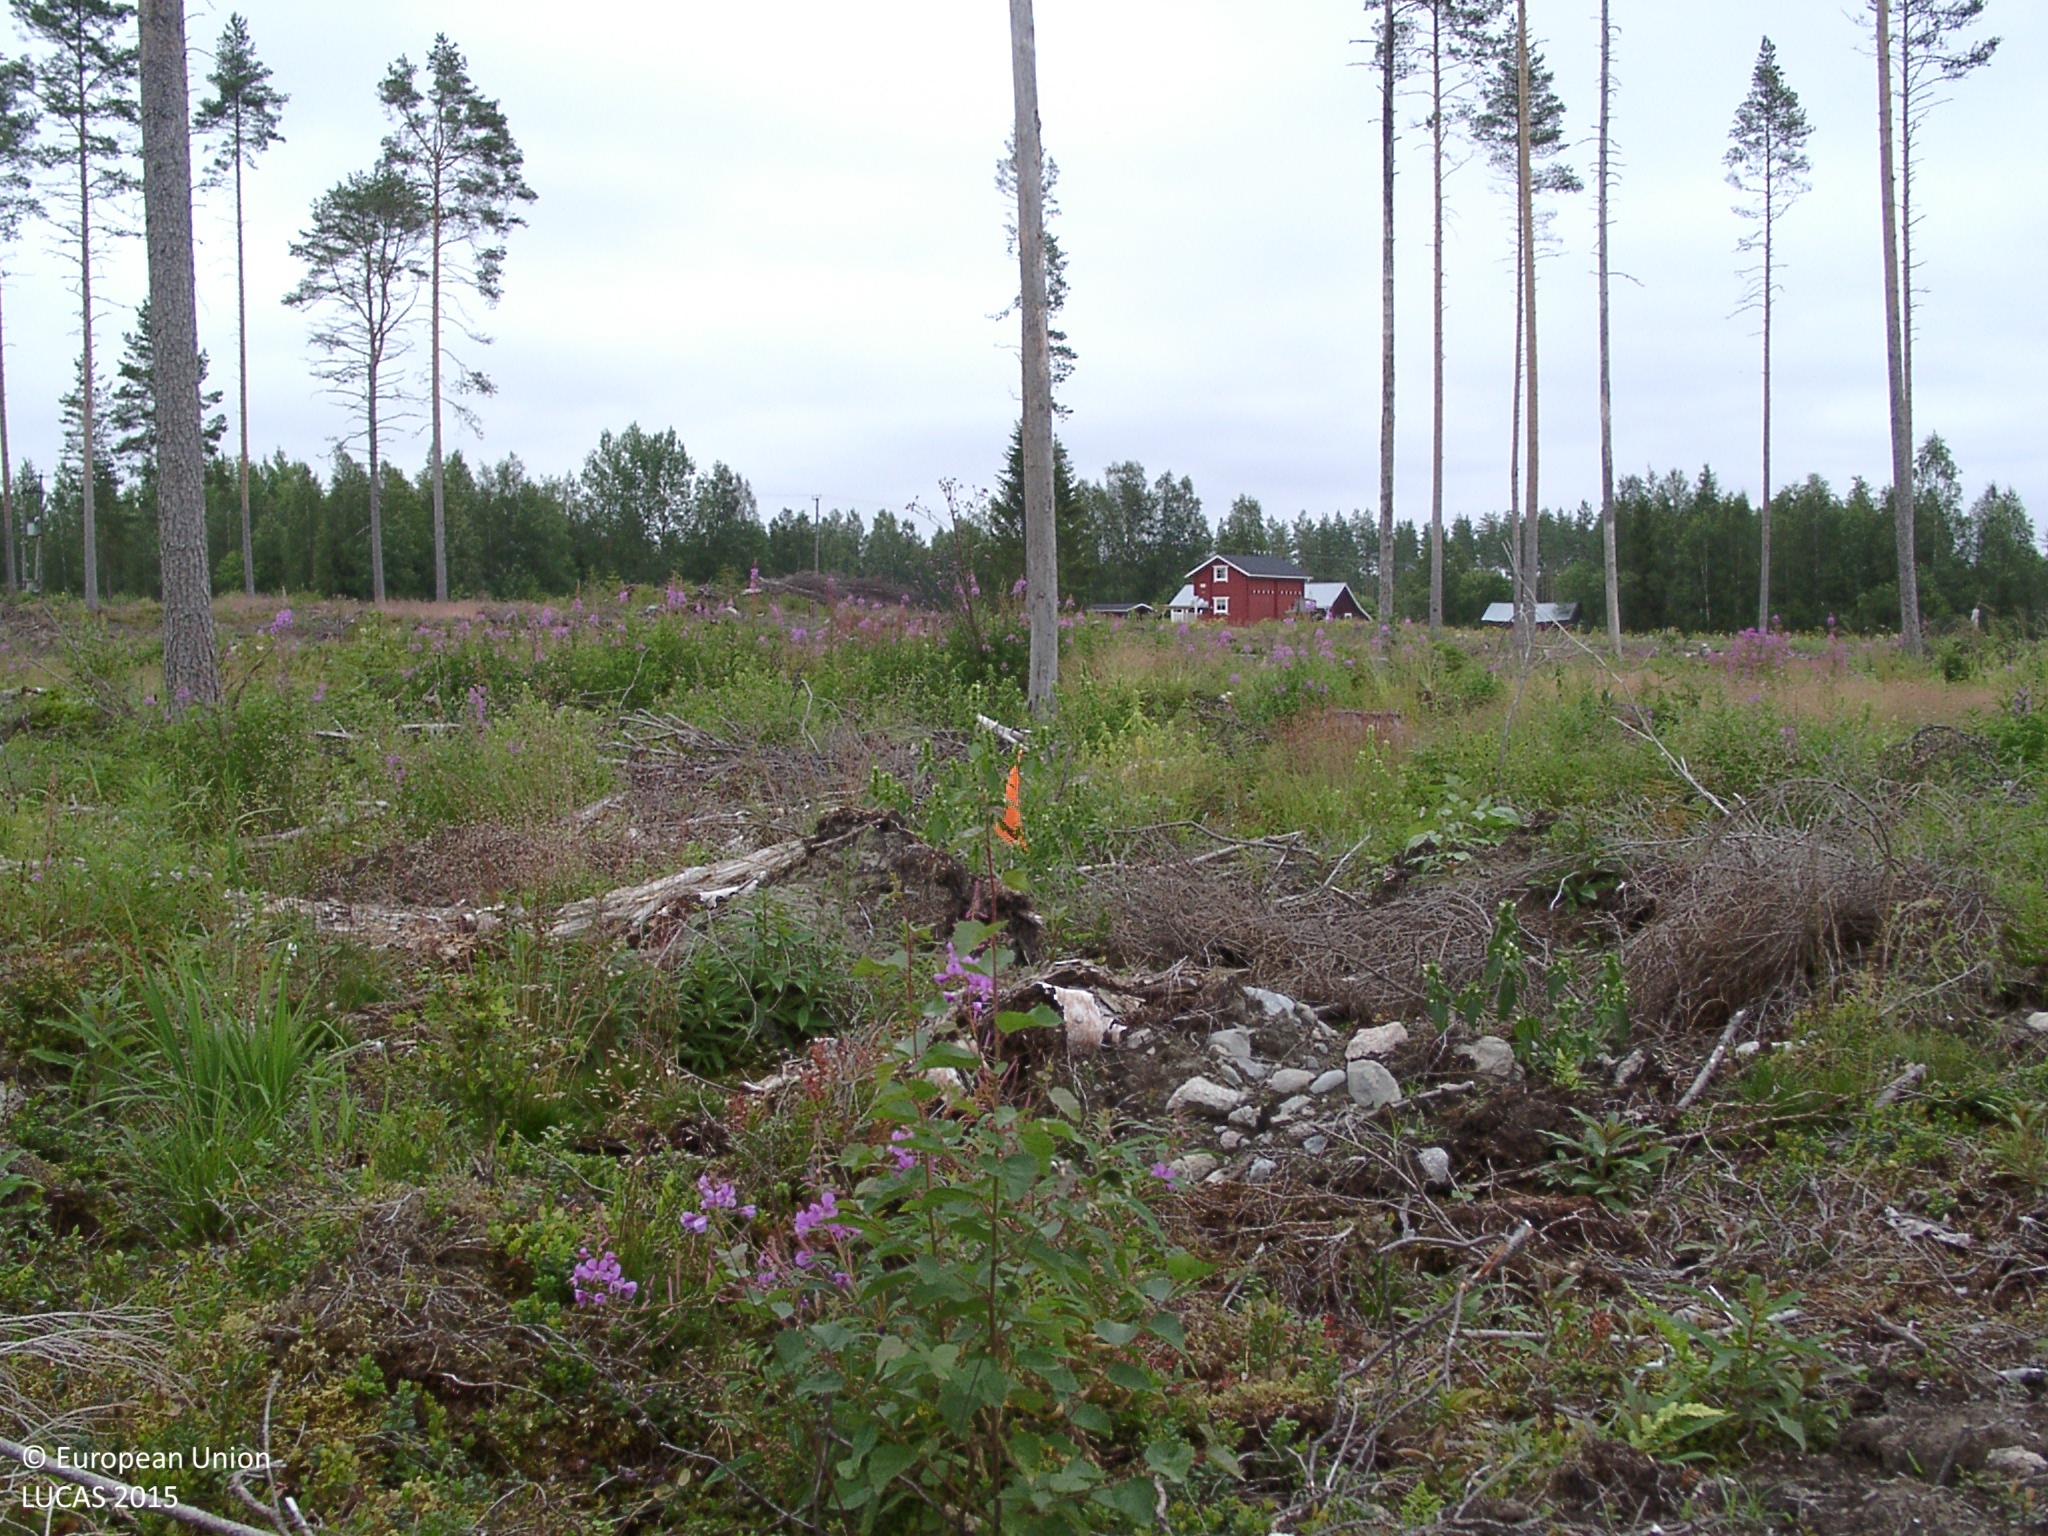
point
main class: Grassland
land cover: Grassland without tree/shrub cover
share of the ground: 50 - 75 %
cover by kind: herbaceous plants 50 %, unconsolidated bare surface 20 %, shrubs 5 %, lichens and mosses 5 %
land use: Forestry
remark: Clear cut
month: August
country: FI
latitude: 62.8830
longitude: 24.6611
